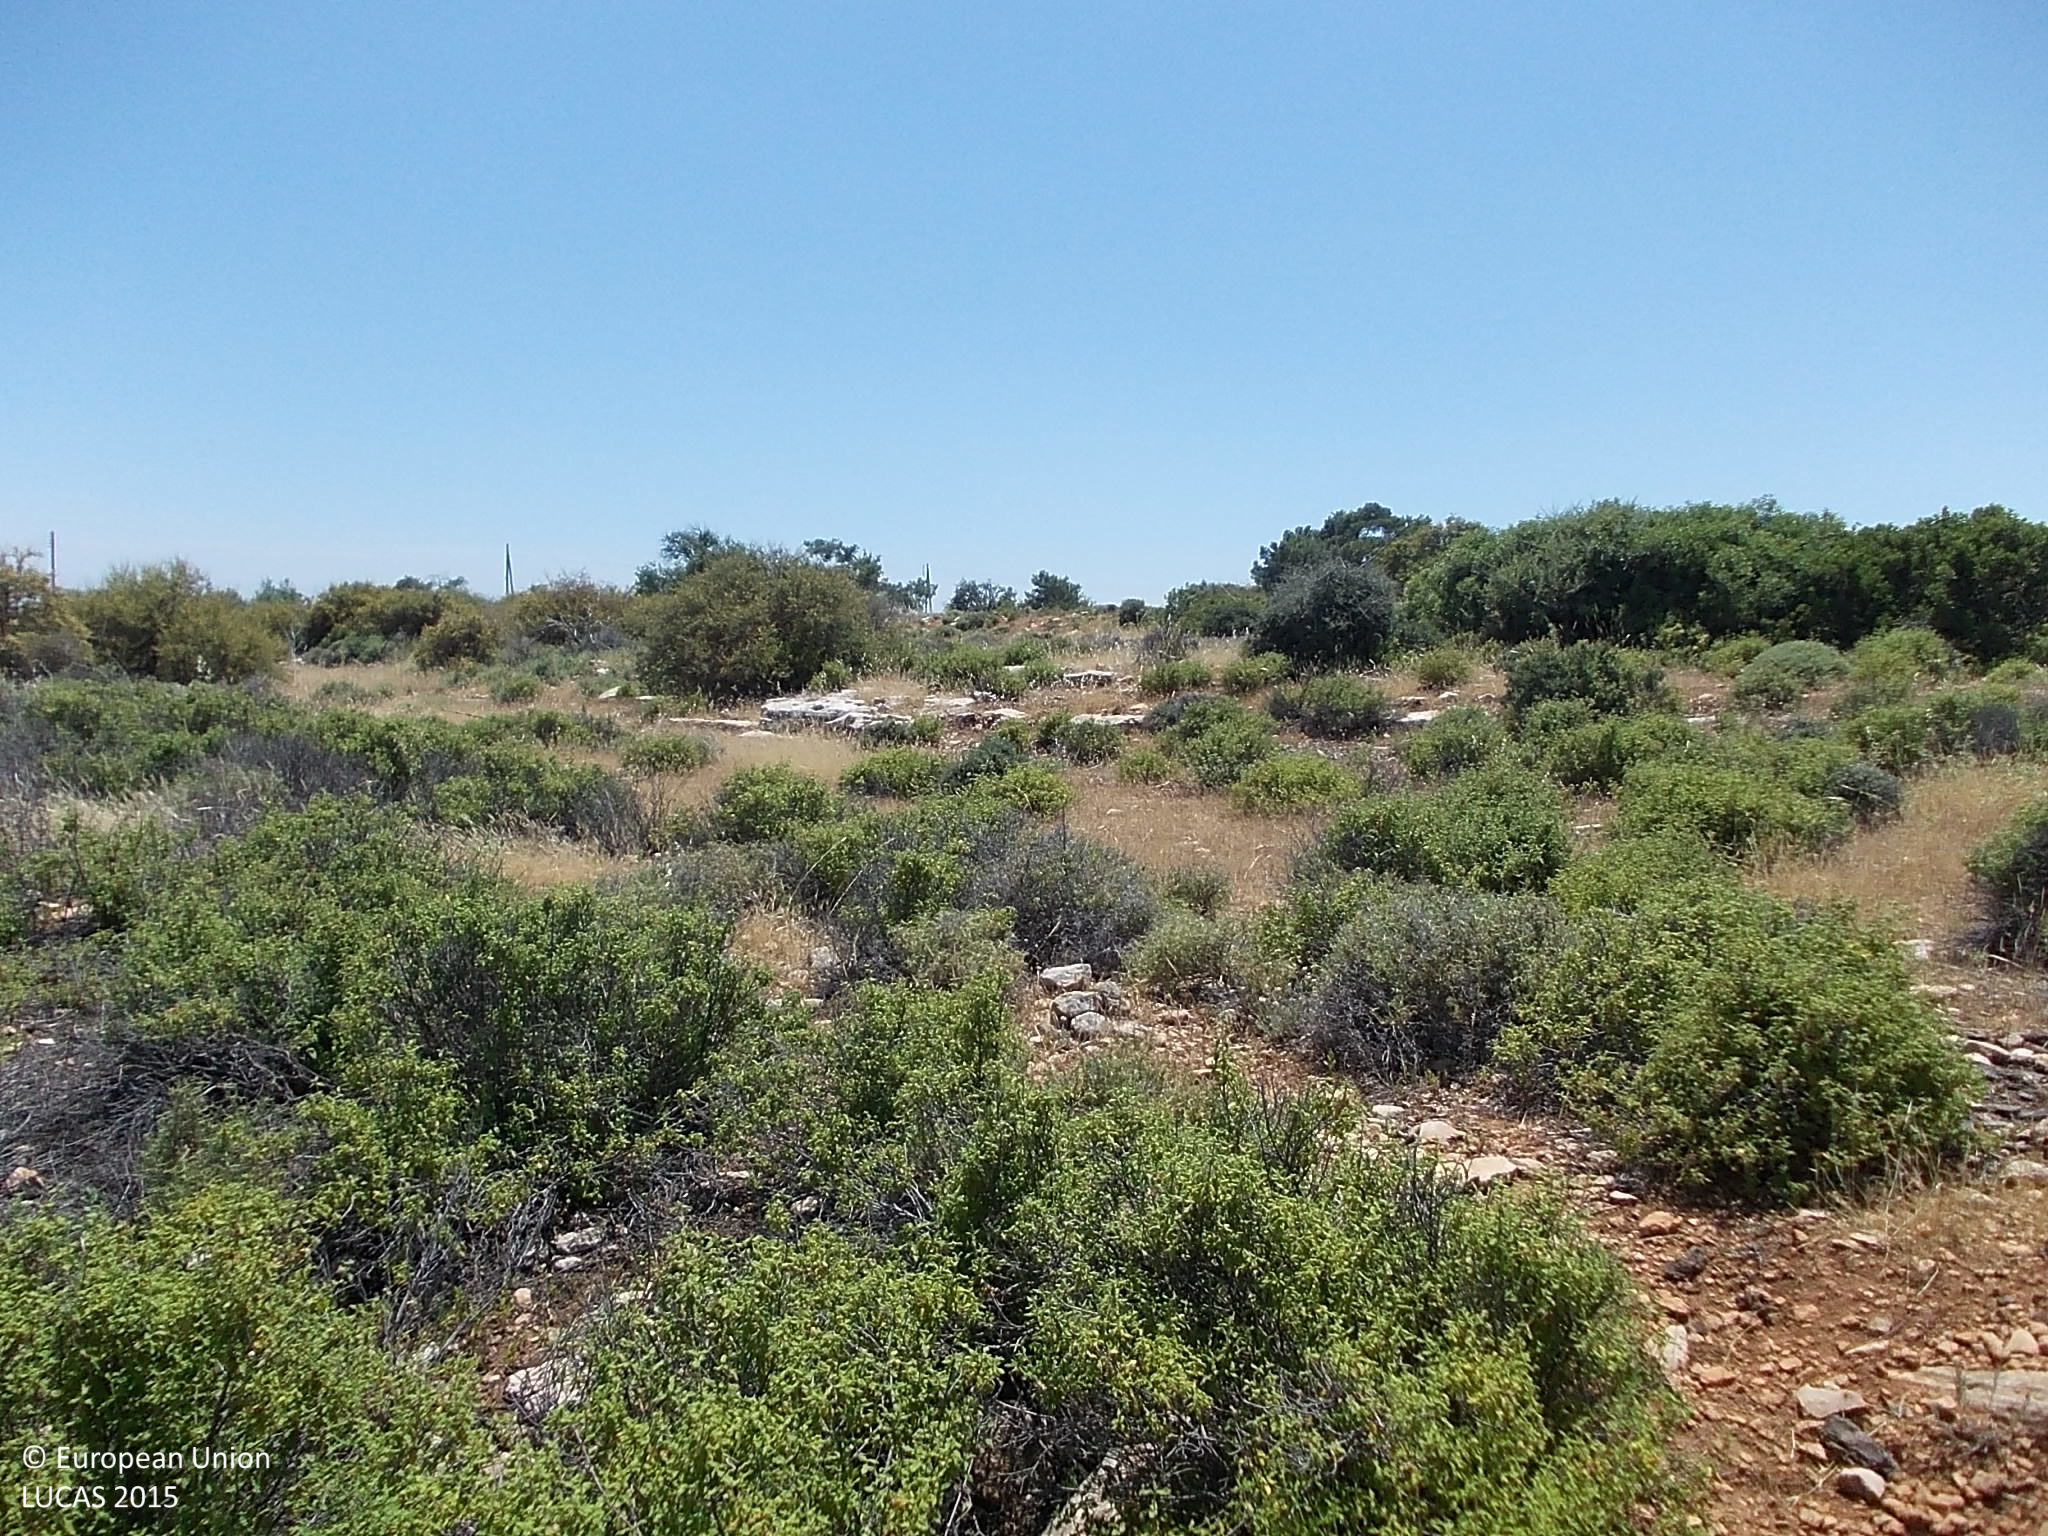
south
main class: Shrubland
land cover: Shrubland without tree cover
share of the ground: 50 - 75 %
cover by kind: shrubs 65 %, herbaceous plants 20 %, unconsolidated bare surface 10 %, consolidated bare surface 5 %
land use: Semi-natural and natural areas not in use
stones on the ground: 10 - 25 %
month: June
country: CY
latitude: 34.7291
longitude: 32.8868
